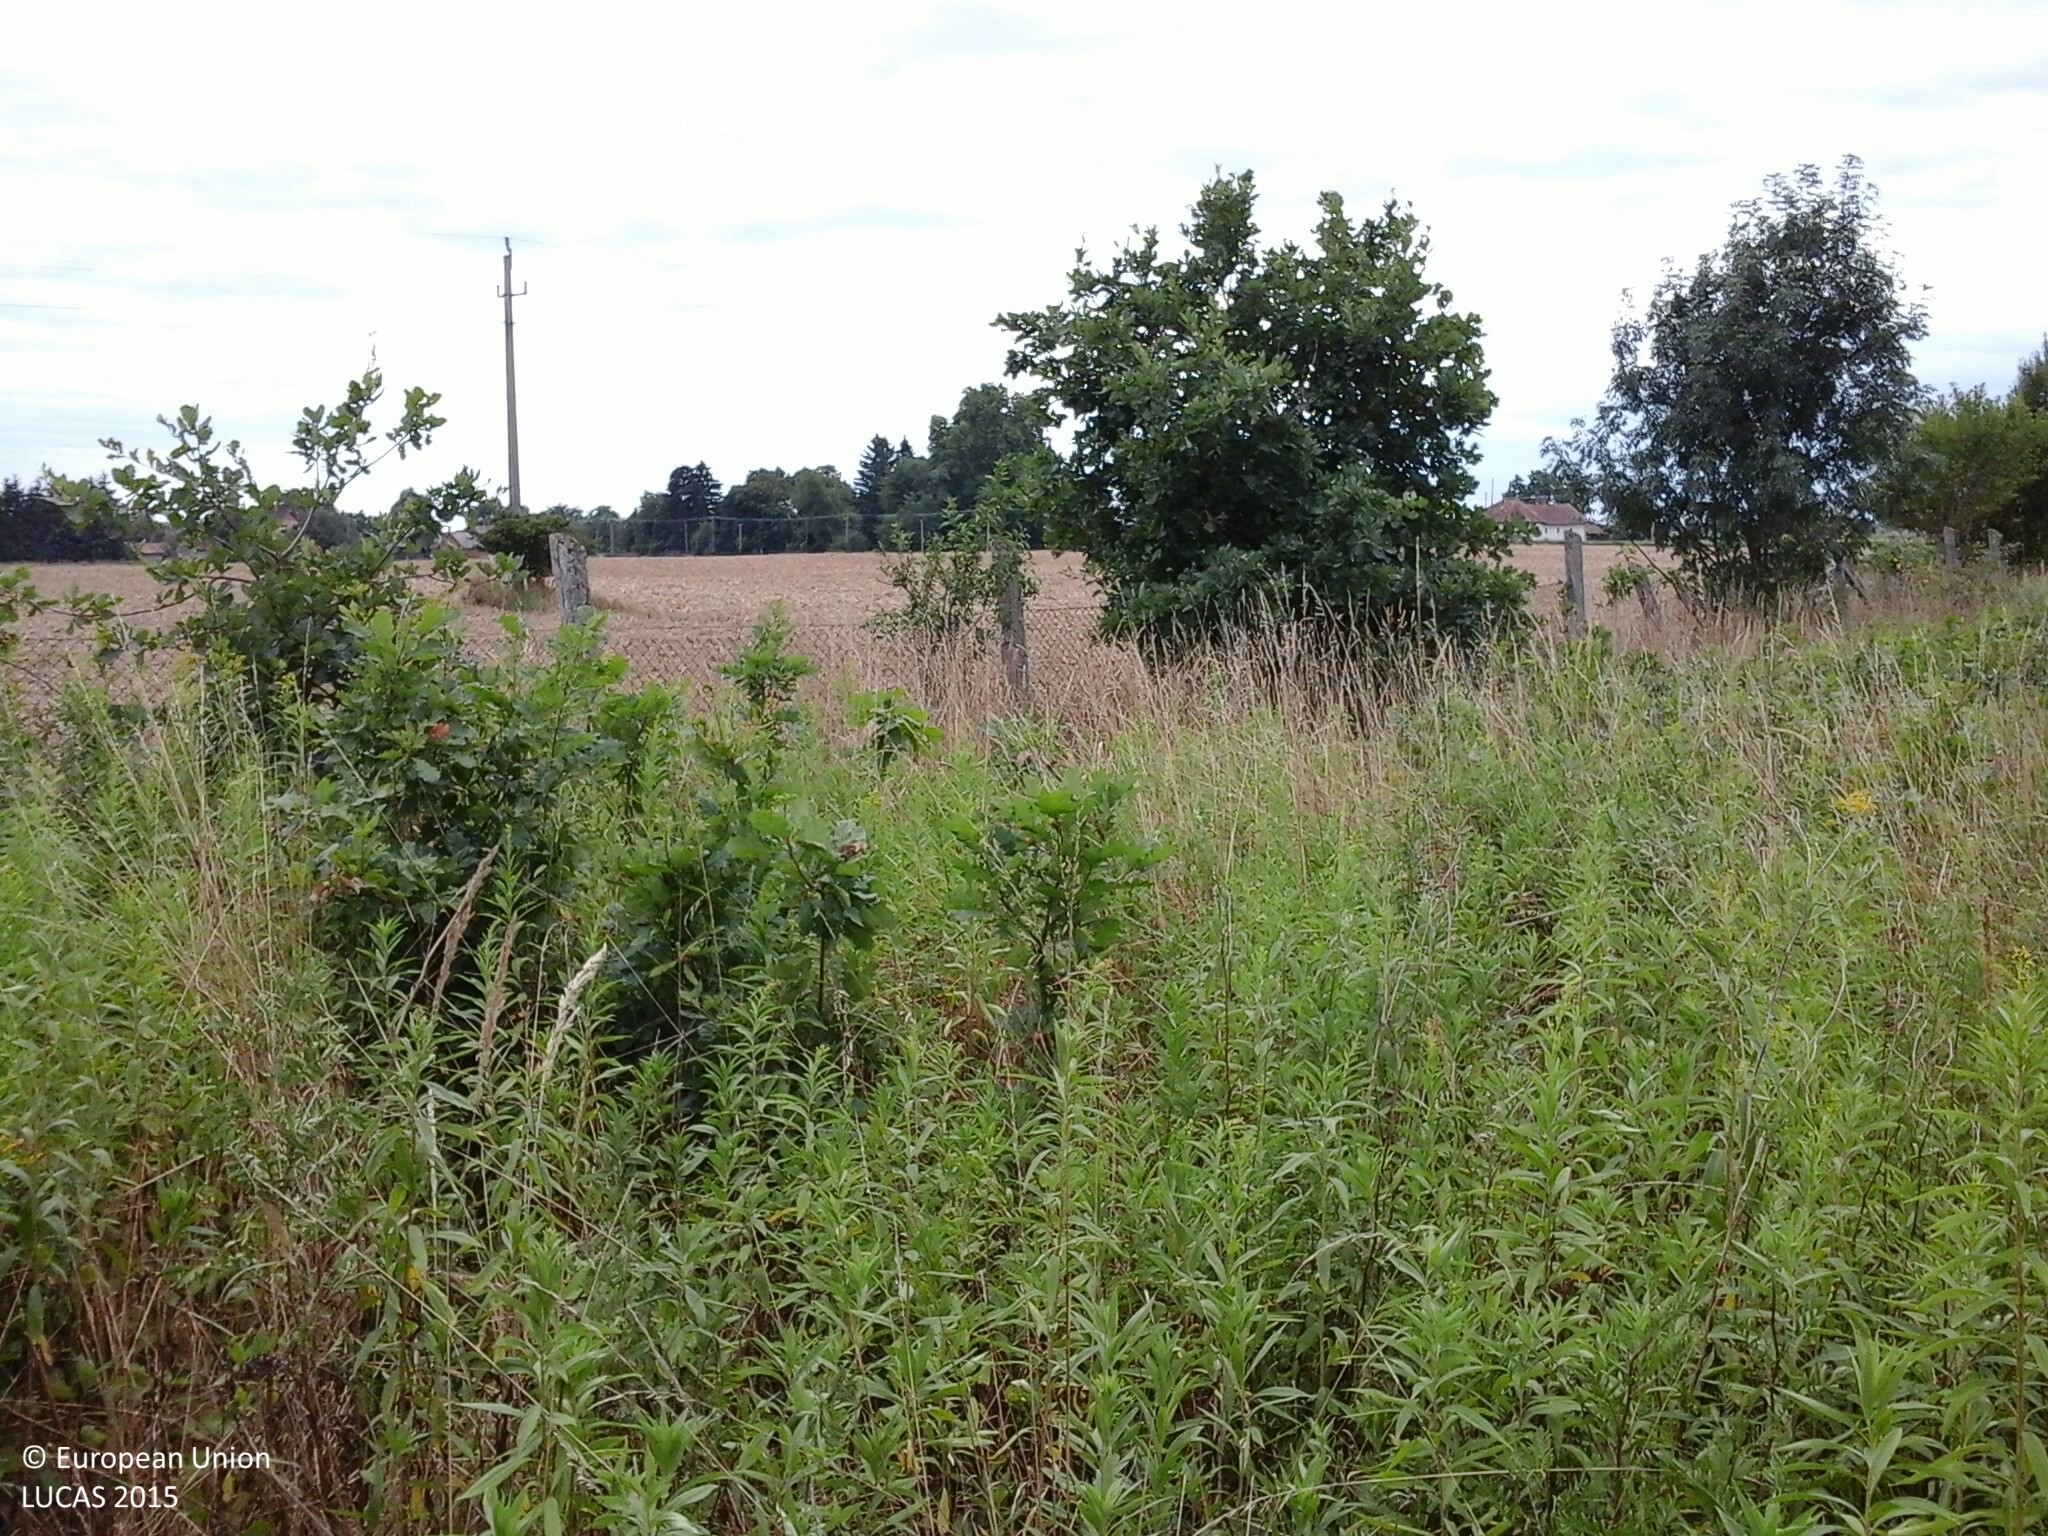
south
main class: Shrubland
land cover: Shrubland with sparse tree cover
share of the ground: > 75 %
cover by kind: shrubs 65 %, herbaceous plants 30 %, broadleaved forest trees 5 %
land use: Semi-natural and natural areas not in use
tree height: < 5 m
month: July
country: HU
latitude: 46.7117
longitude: 16.5293
